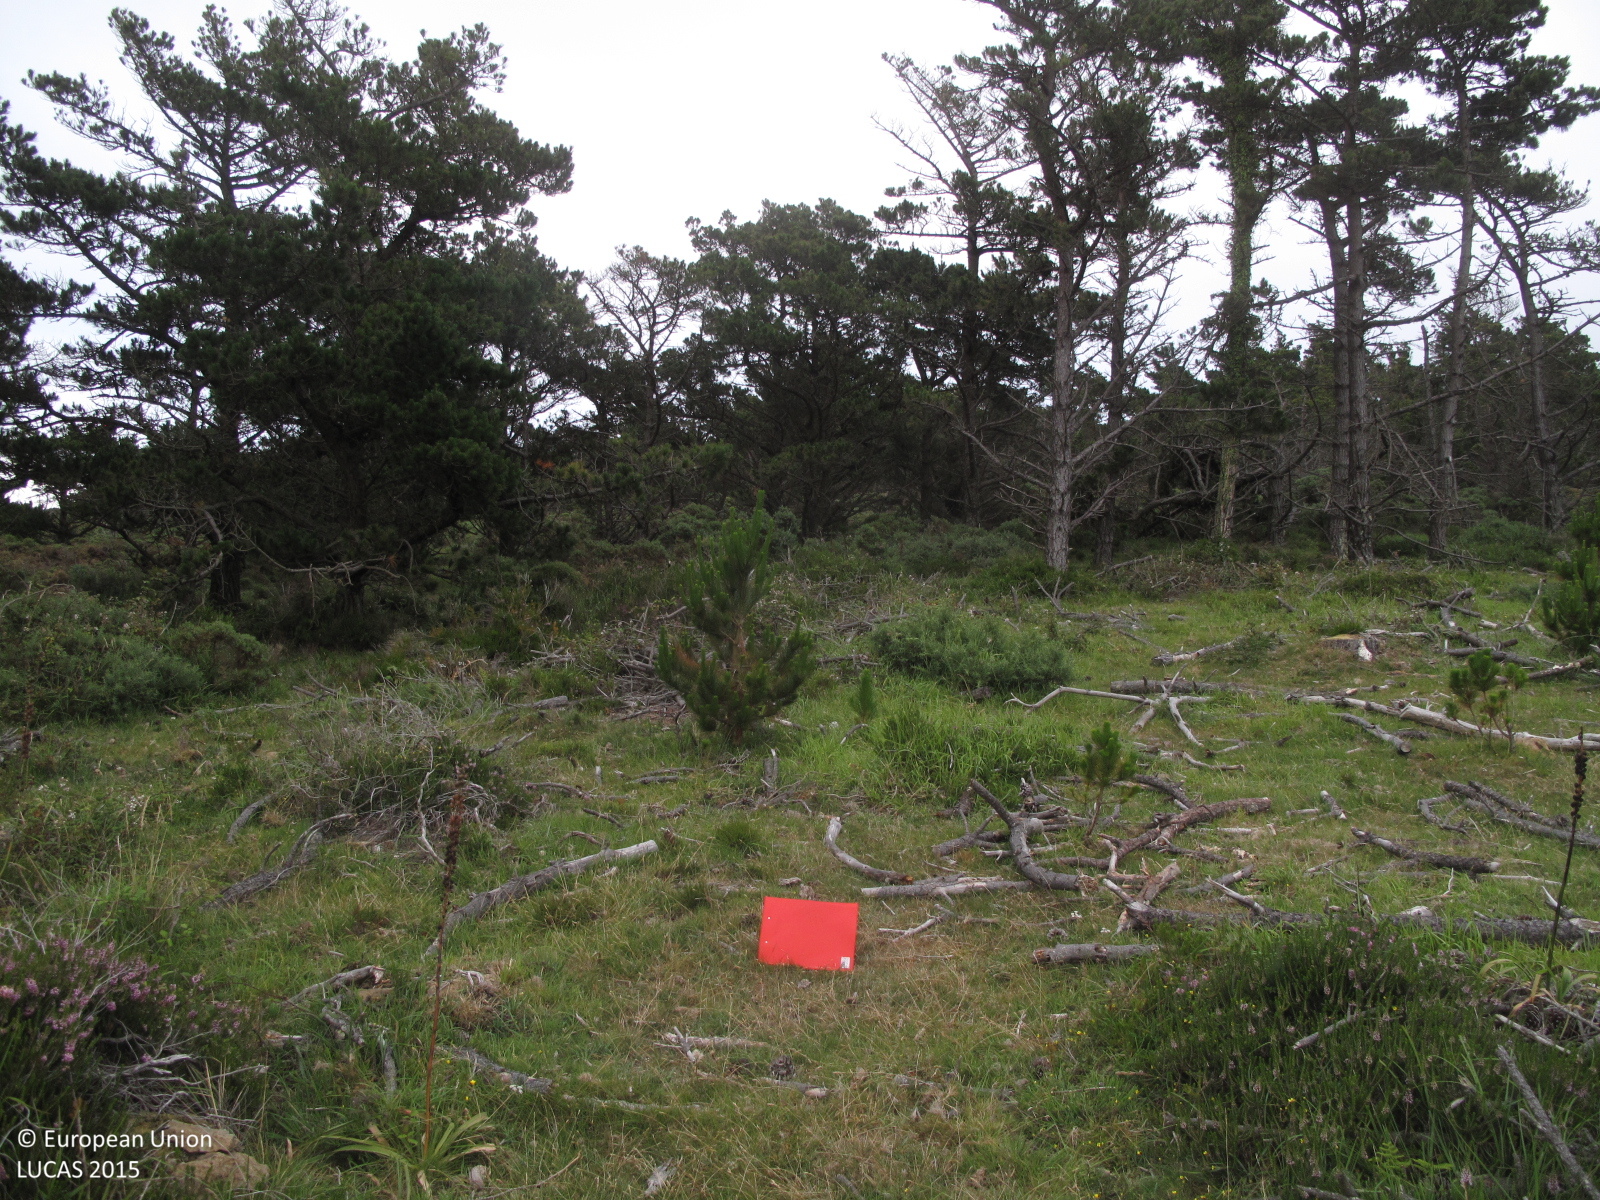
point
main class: Woodland
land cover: Pine dominated coniferous woodland
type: exotic forest
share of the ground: 25 - 50 %
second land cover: Shrubland without tree cover
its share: 10 - 25 %
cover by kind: coniferous forest trees 40 %, herbaceous plants 40 %, shrubs 20 %
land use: Forestry
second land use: Agriculture (excluding fallow land and kitchen gardens)
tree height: > 5 m
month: July
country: ES
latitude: 43.7569
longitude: -7.8942
